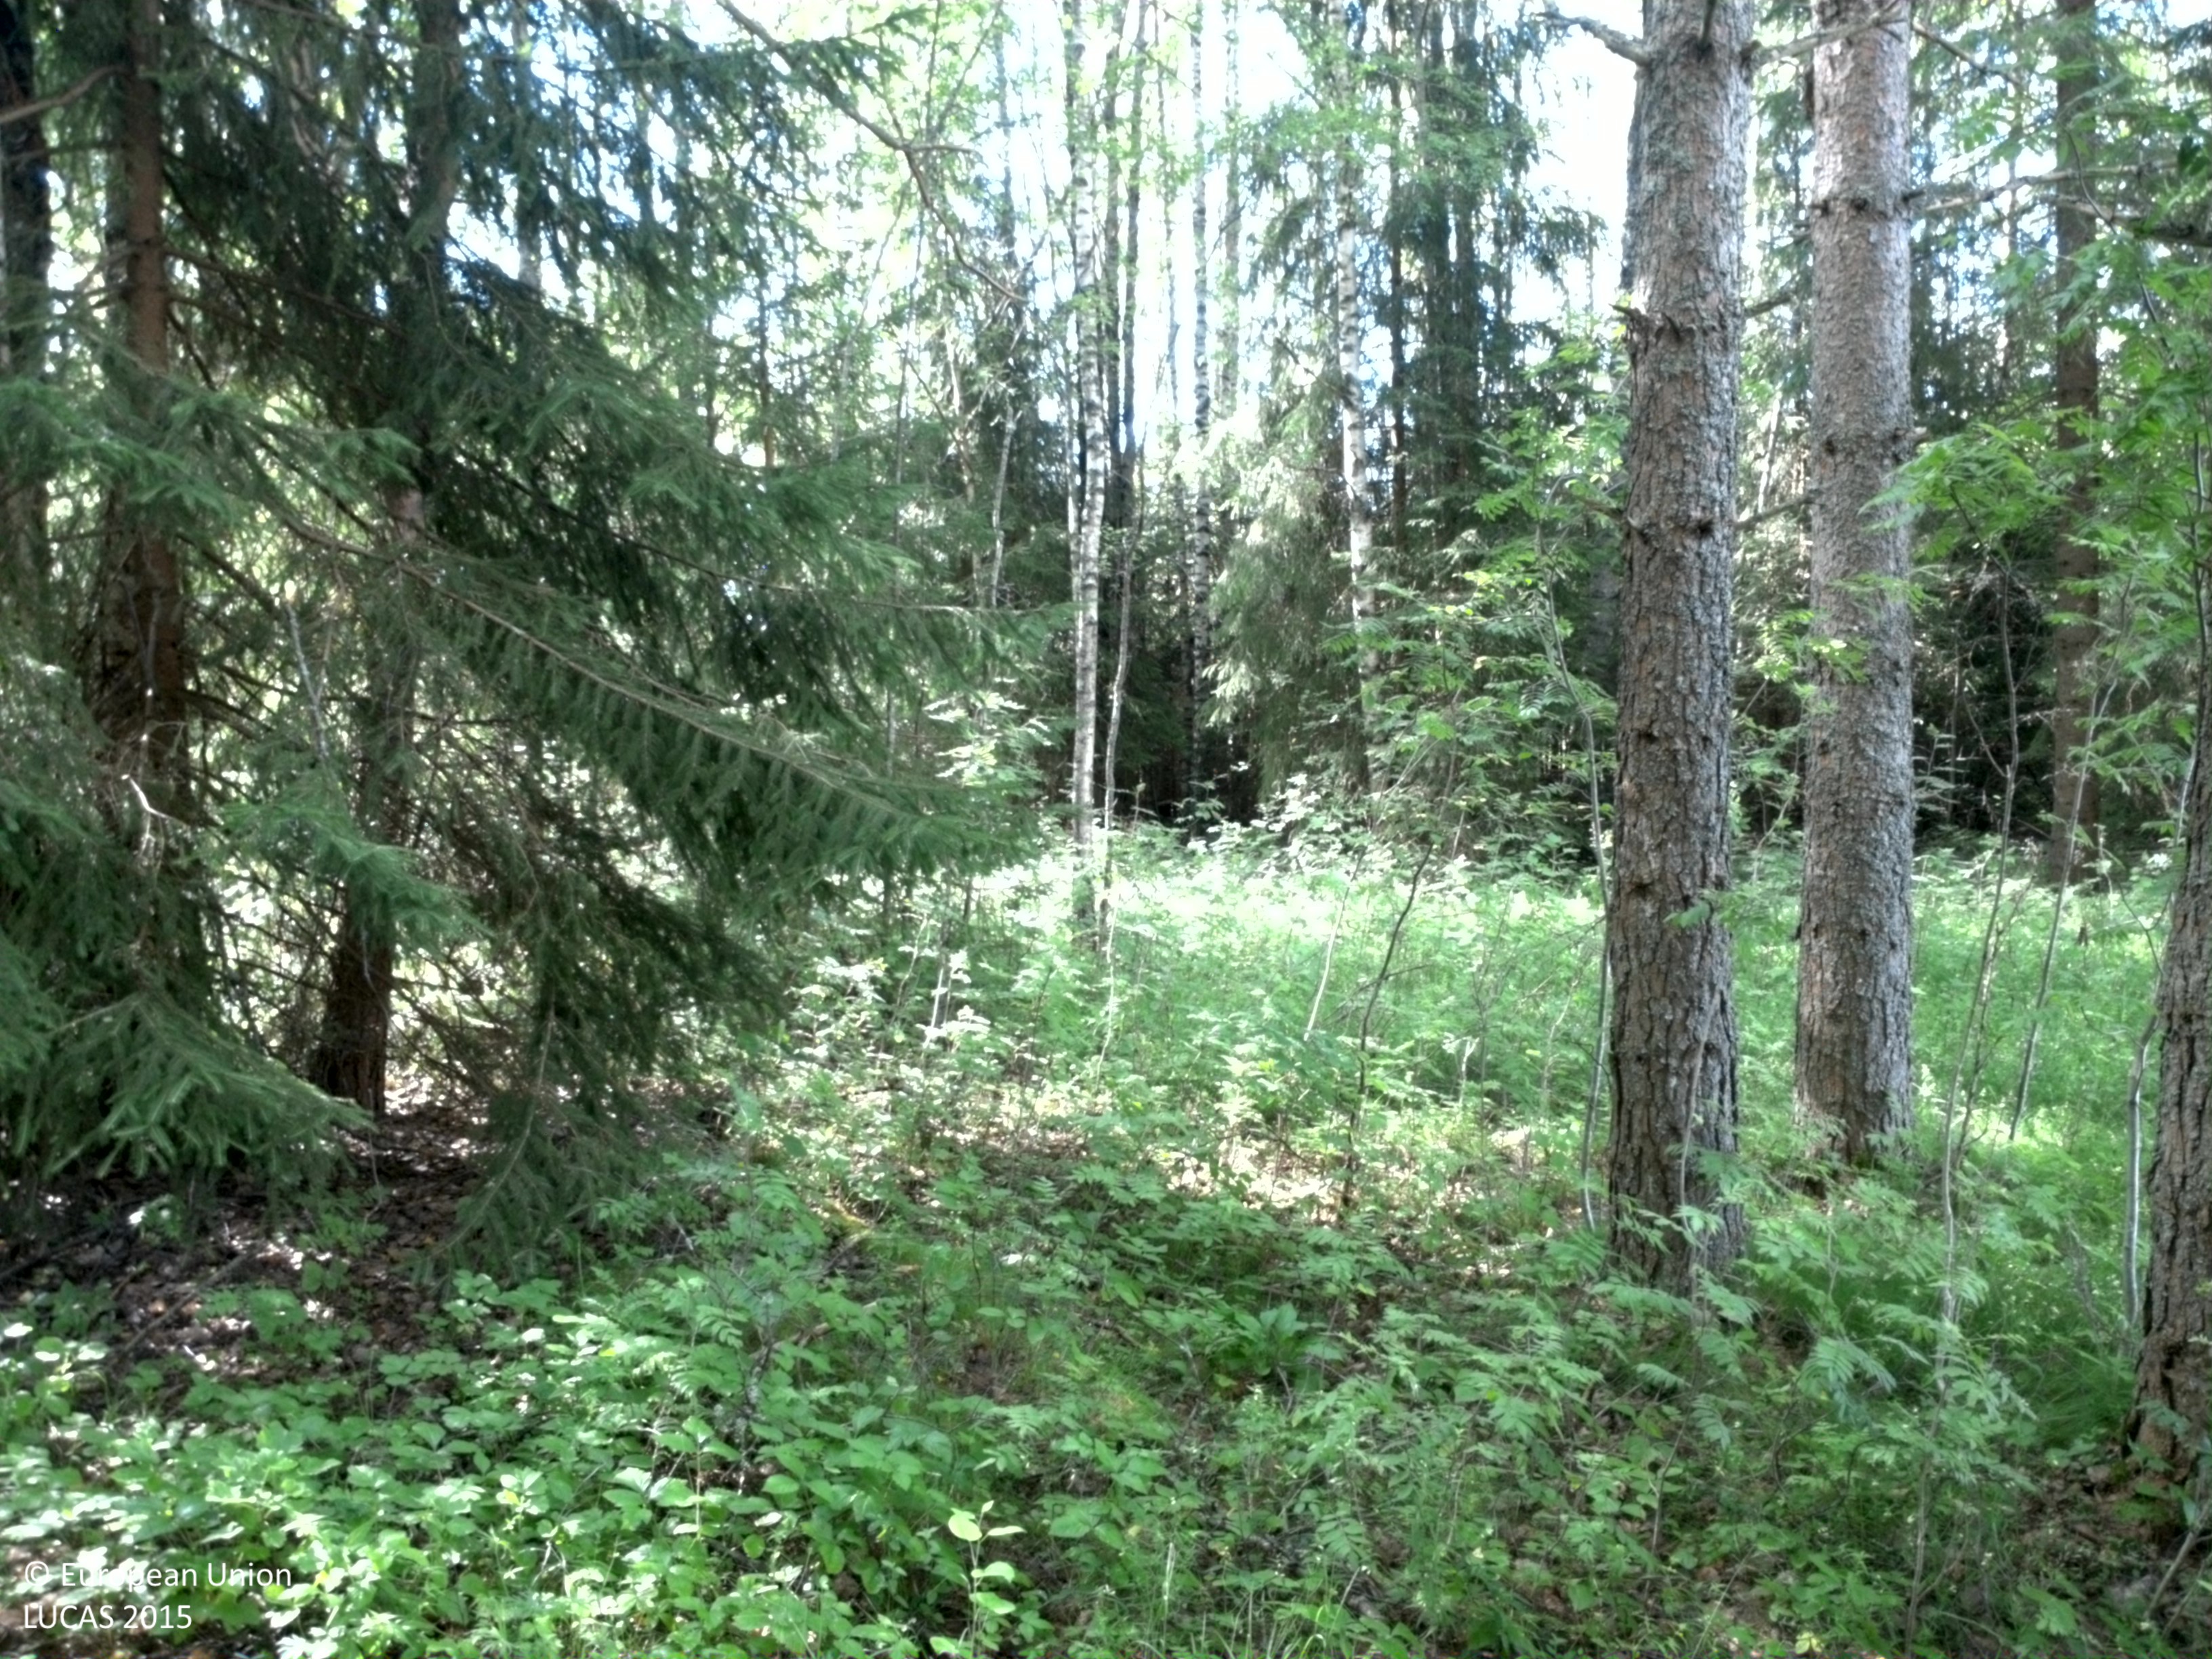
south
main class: Woodland
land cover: Spruce dominated mixed woodland
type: boreal forest
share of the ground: 50 - 75 %
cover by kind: coniferous forest trees 50 %, broadleaved forest trees 25 %, herbaceous plants 20 %, shrubs 5 %
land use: Forestry
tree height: > 5 m
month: July
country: SE
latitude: 60.0729
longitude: 13.1719
